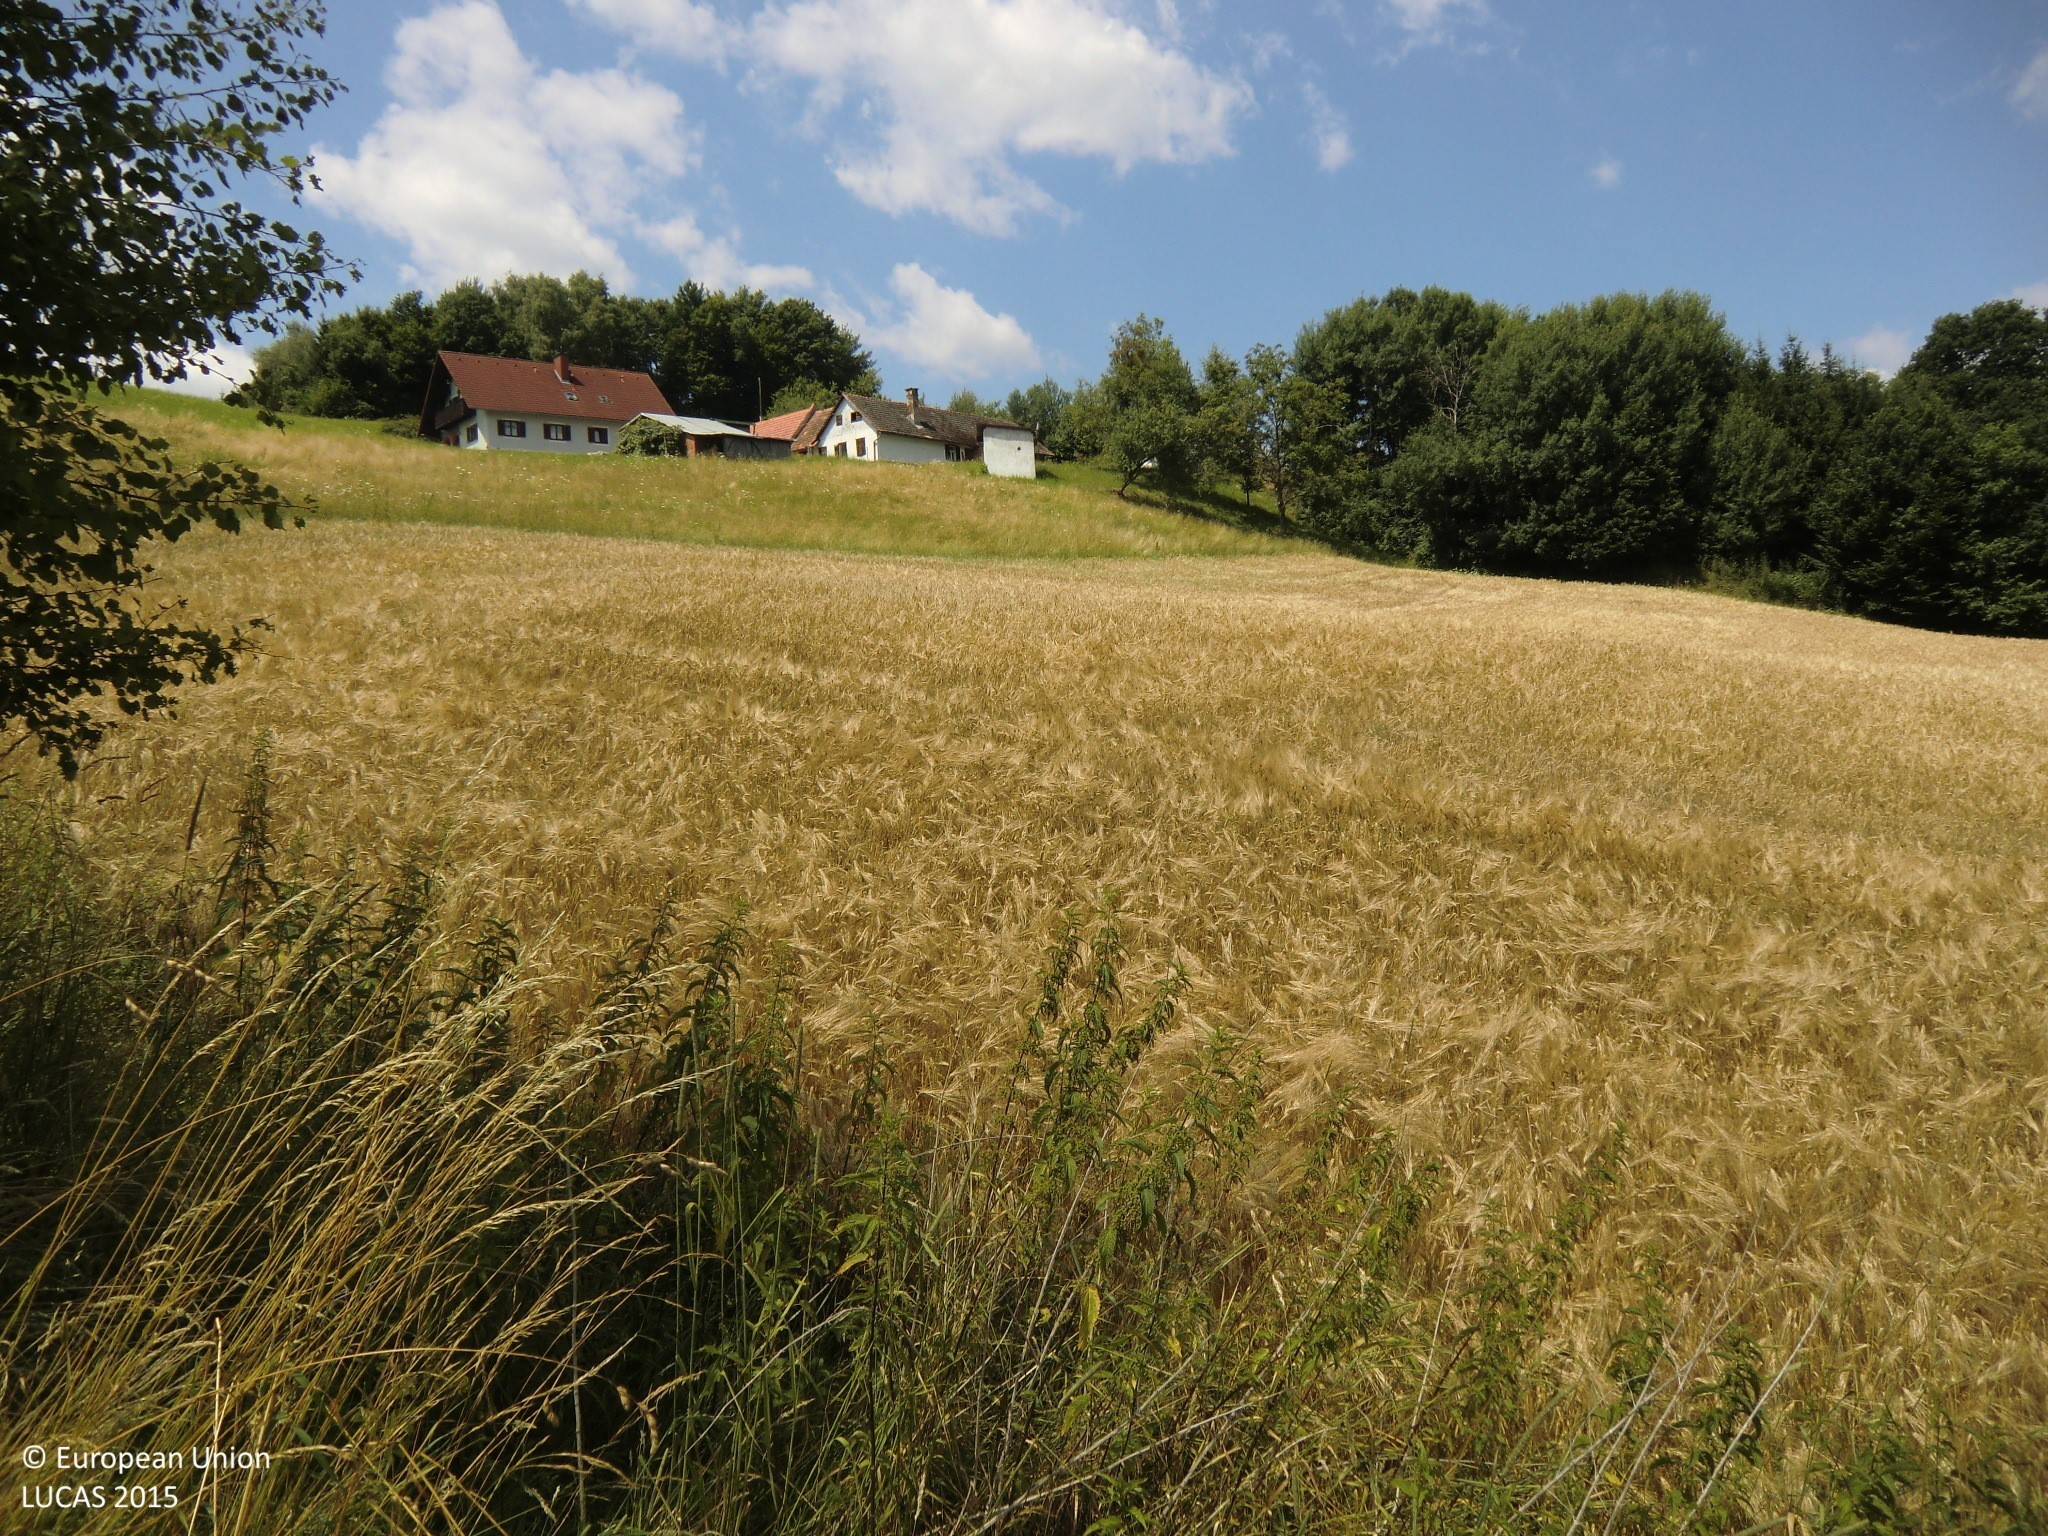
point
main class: Cropland
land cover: Barley
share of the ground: > 75 %
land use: Agriculture (excluding fallow land and kitchen gardens)
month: July
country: AT
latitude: 46.9724
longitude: 16.0870
